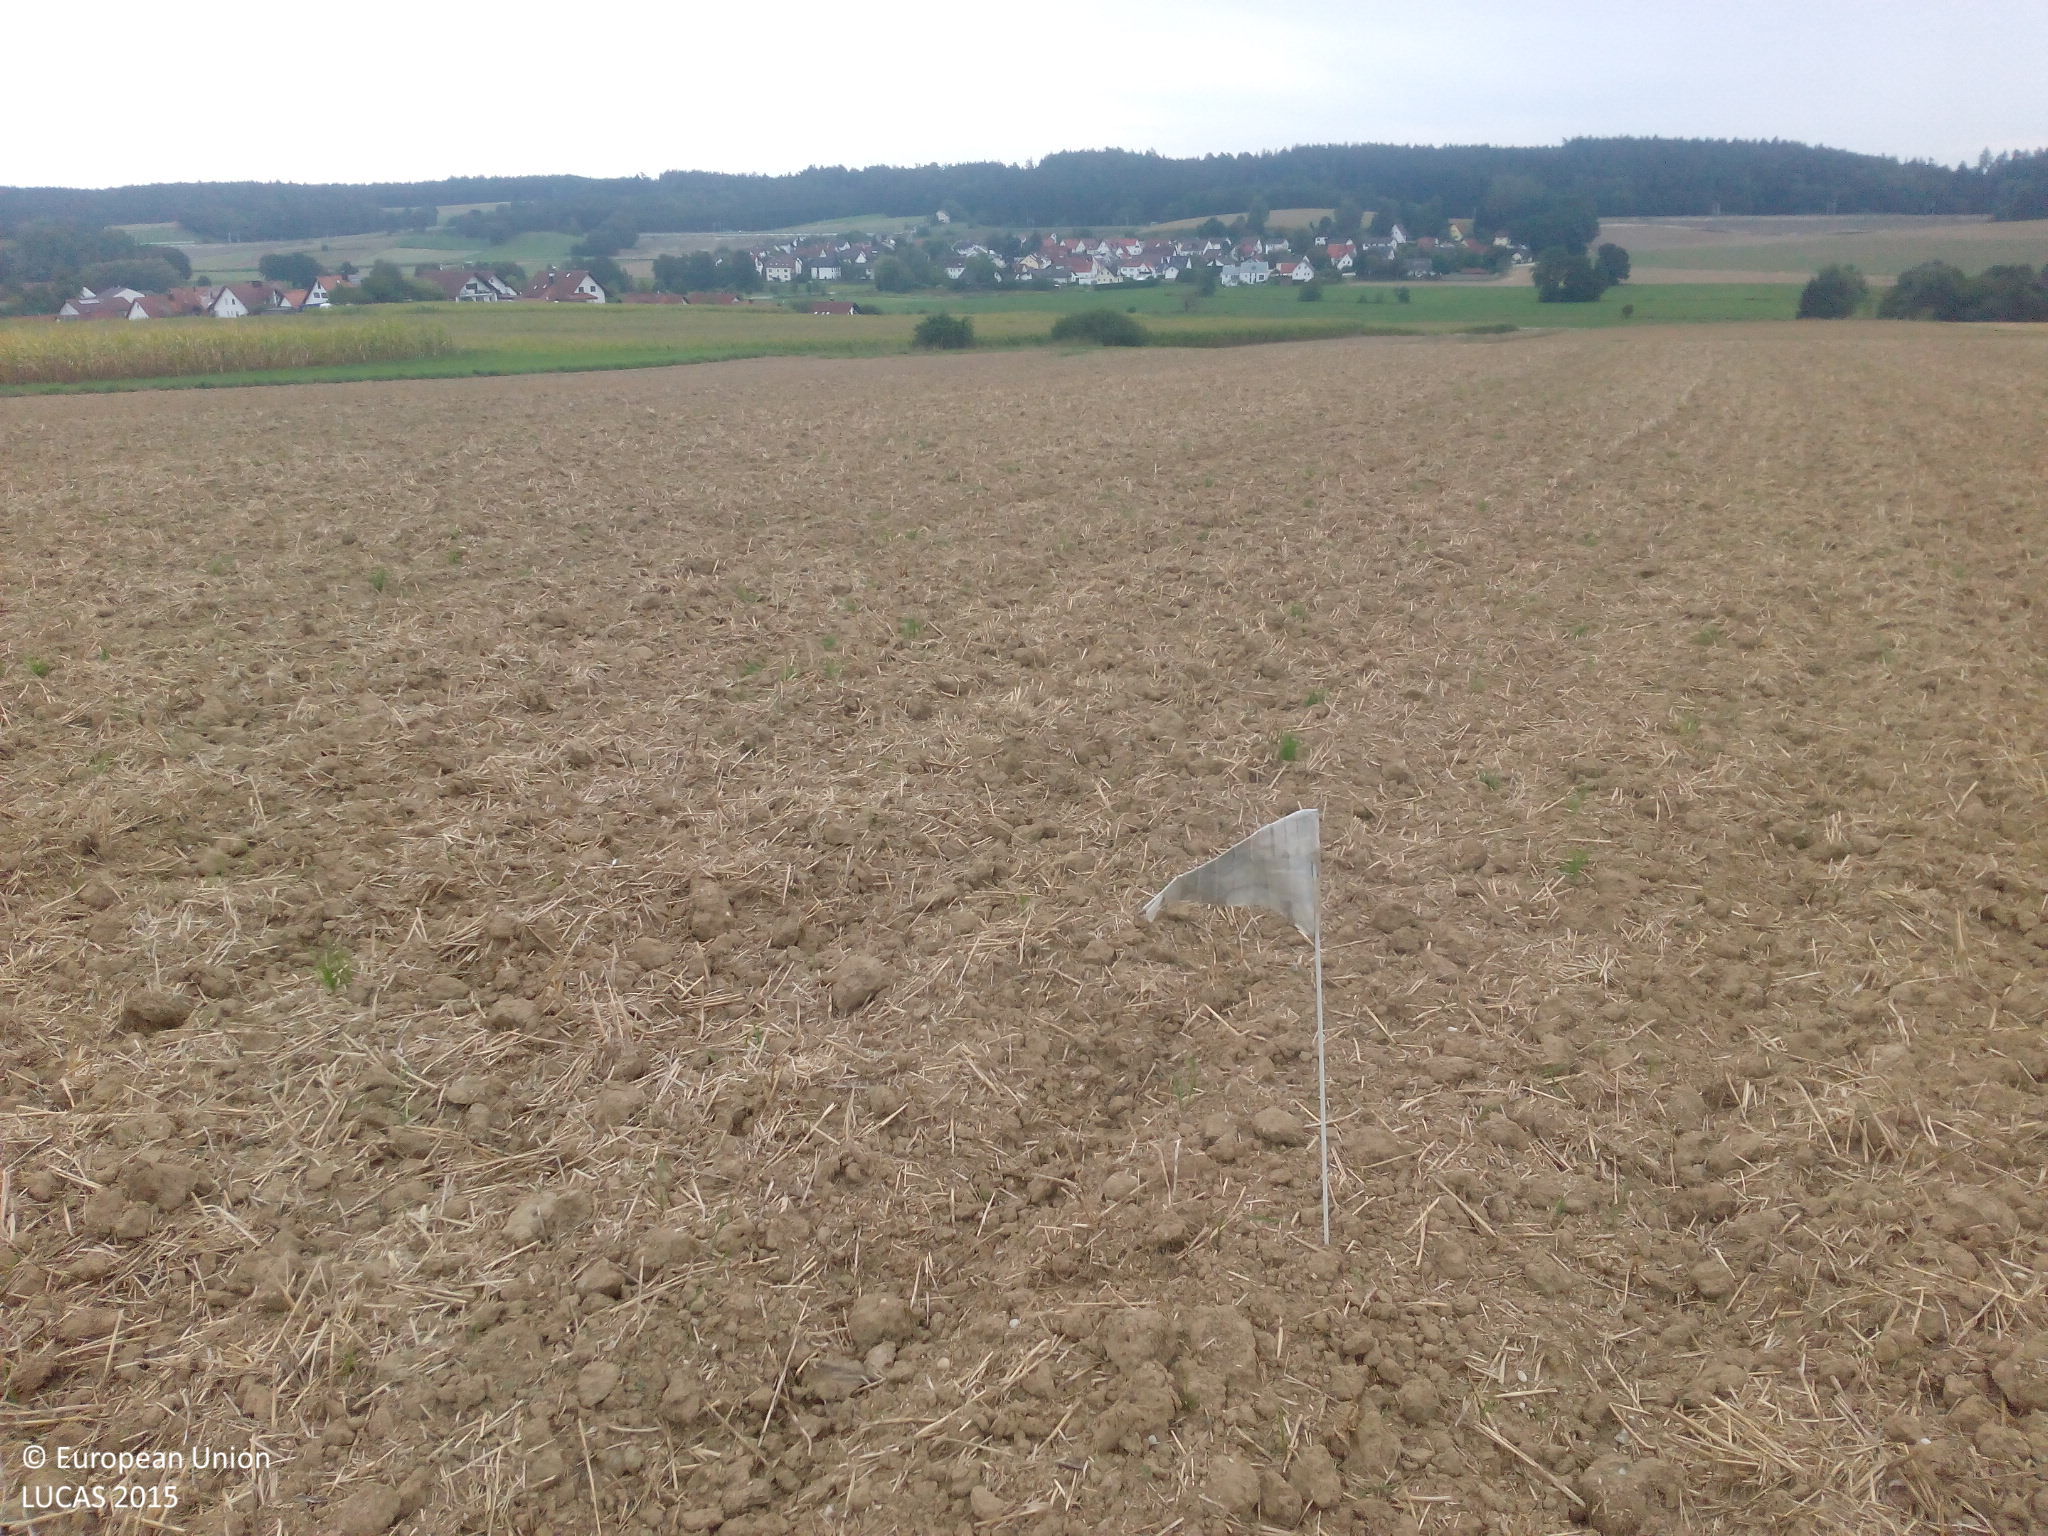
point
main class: Cropland
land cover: Common wheat
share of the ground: < 10 %
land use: Agriculture (excluding fallow land and kitchen gardens)
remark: Harvested field
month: September
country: DE
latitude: 48.4477
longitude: 11.4729
